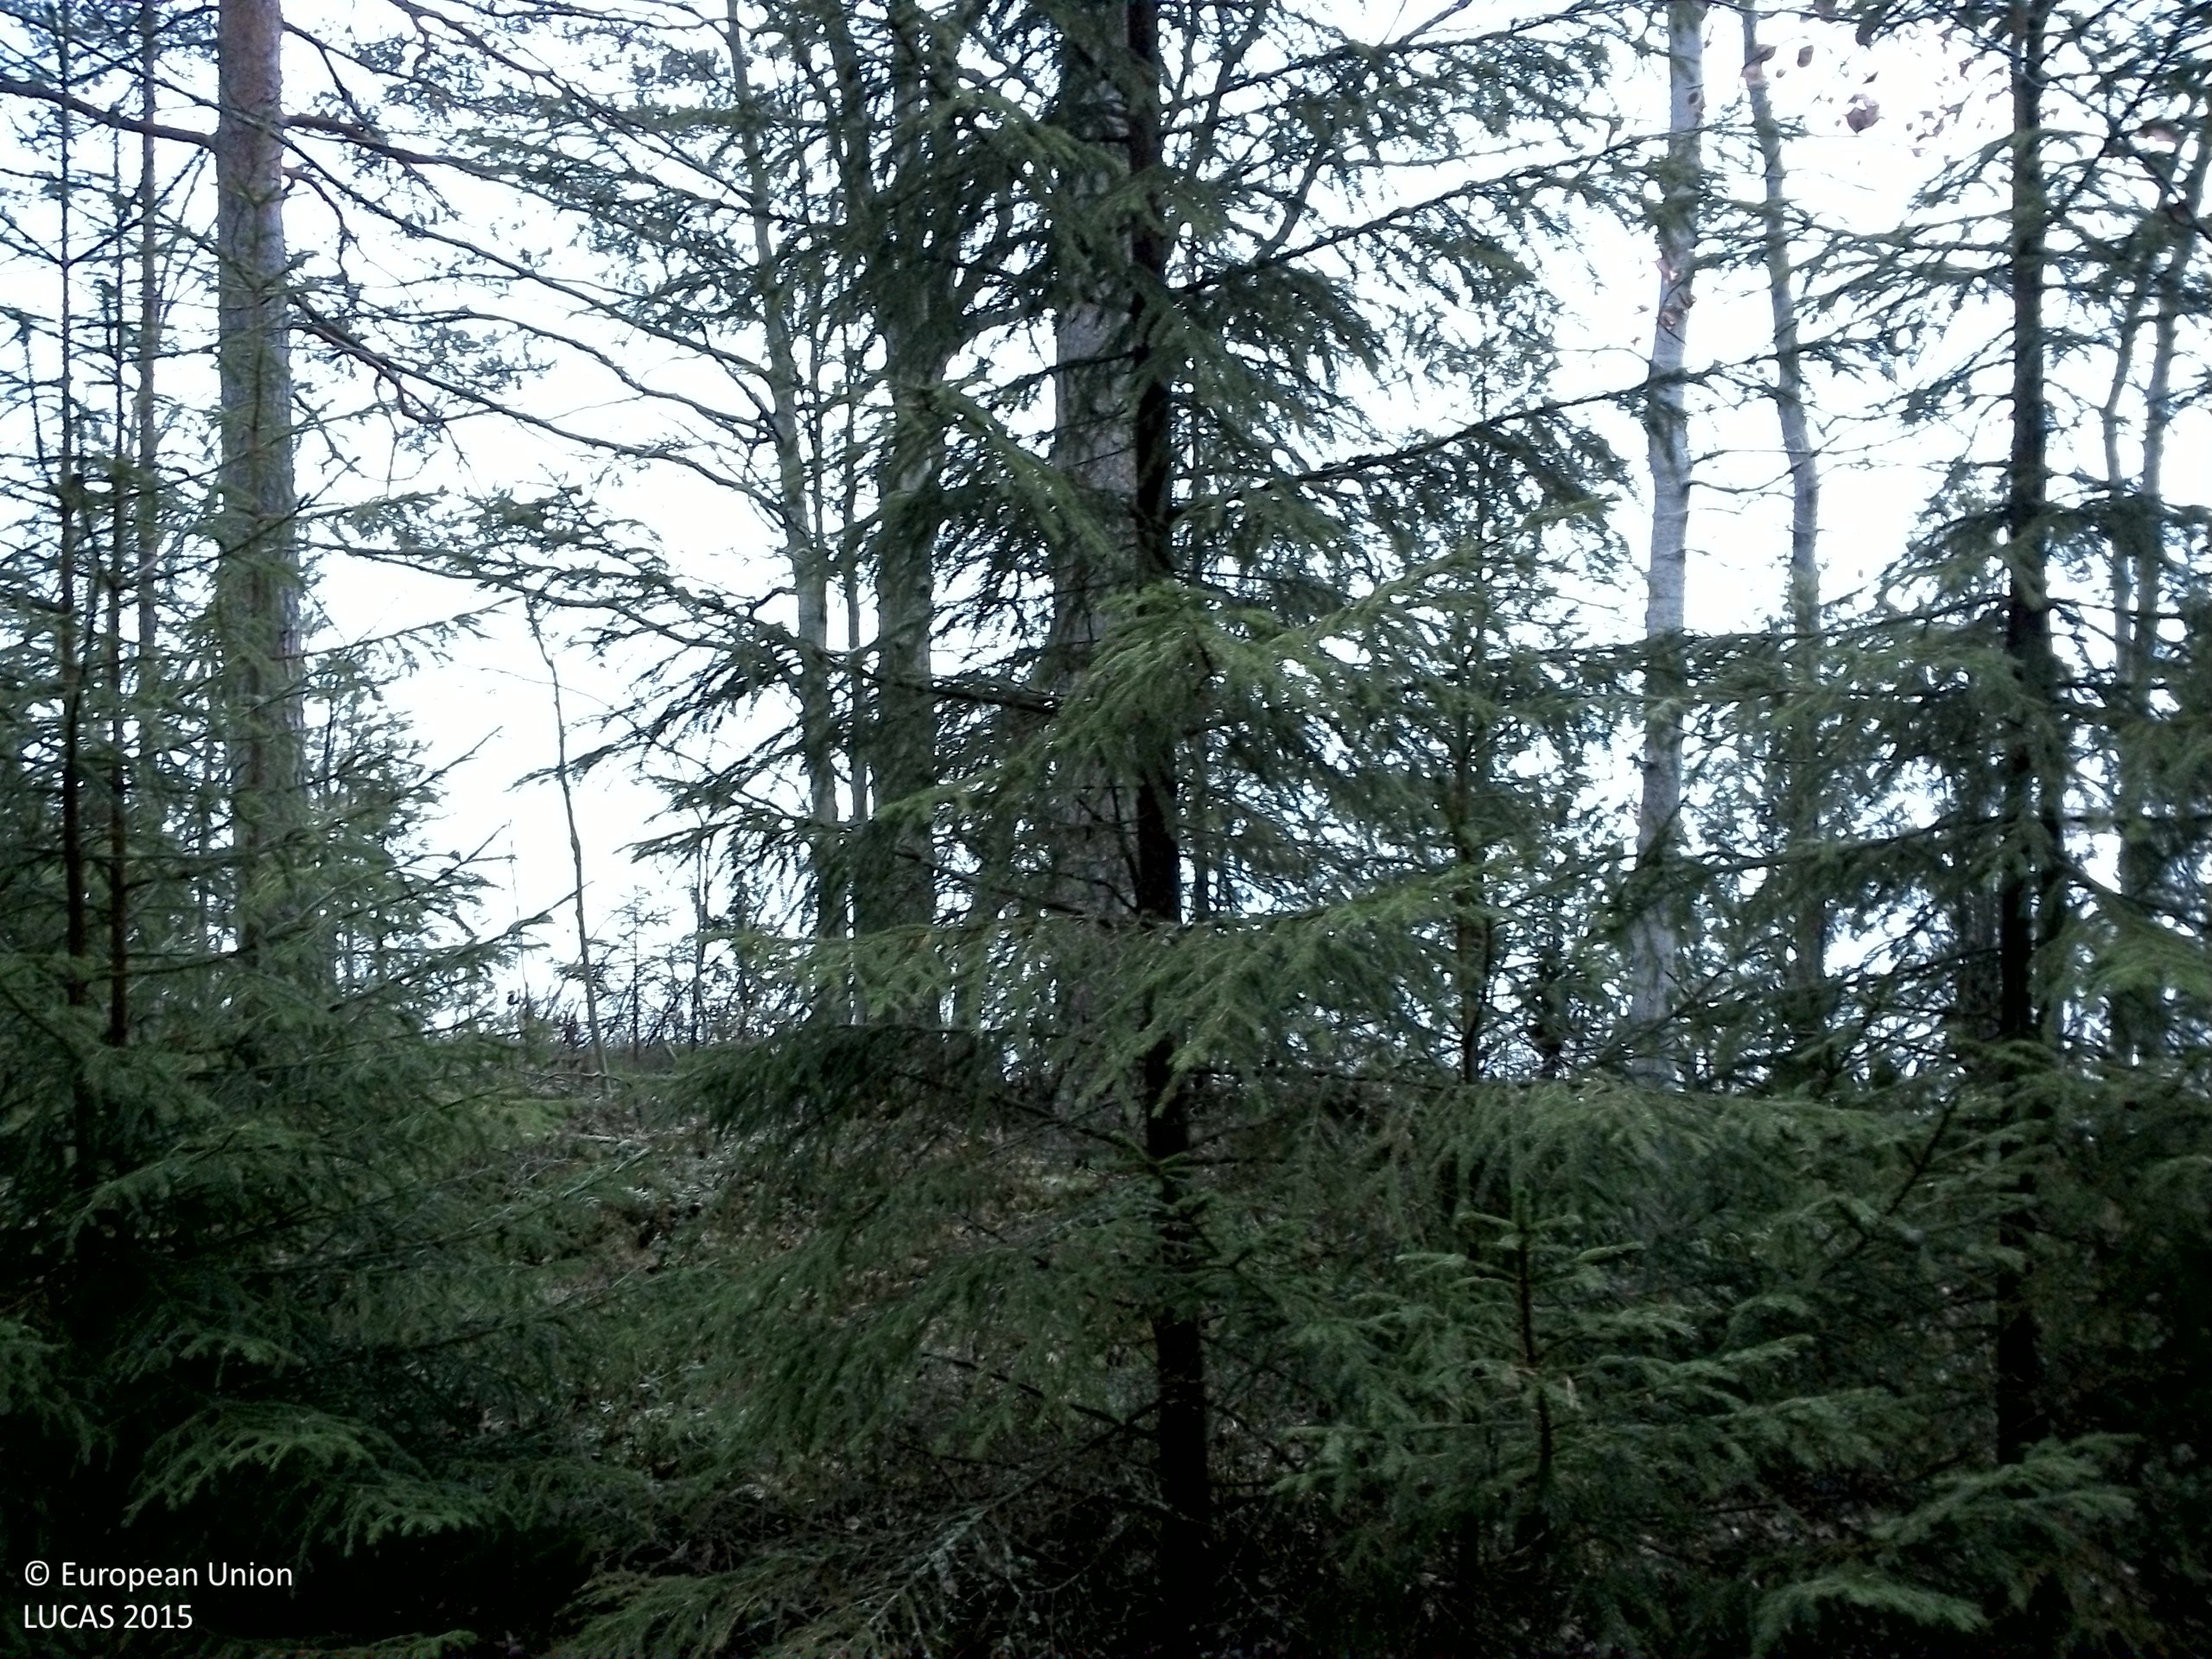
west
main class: Woodland
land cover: Other coniferous woodland
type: boreal forest
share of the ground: 50 - 75 %
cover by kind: coniferous forest trees 60 %, shrubs 25 %, lichens and mosses 10 %, broadleaved forest trees 5 %
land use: Forestry
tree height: > 5 m
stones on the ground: < 10 %
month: November
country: SE
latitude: 60.3513
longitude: 16.6041
